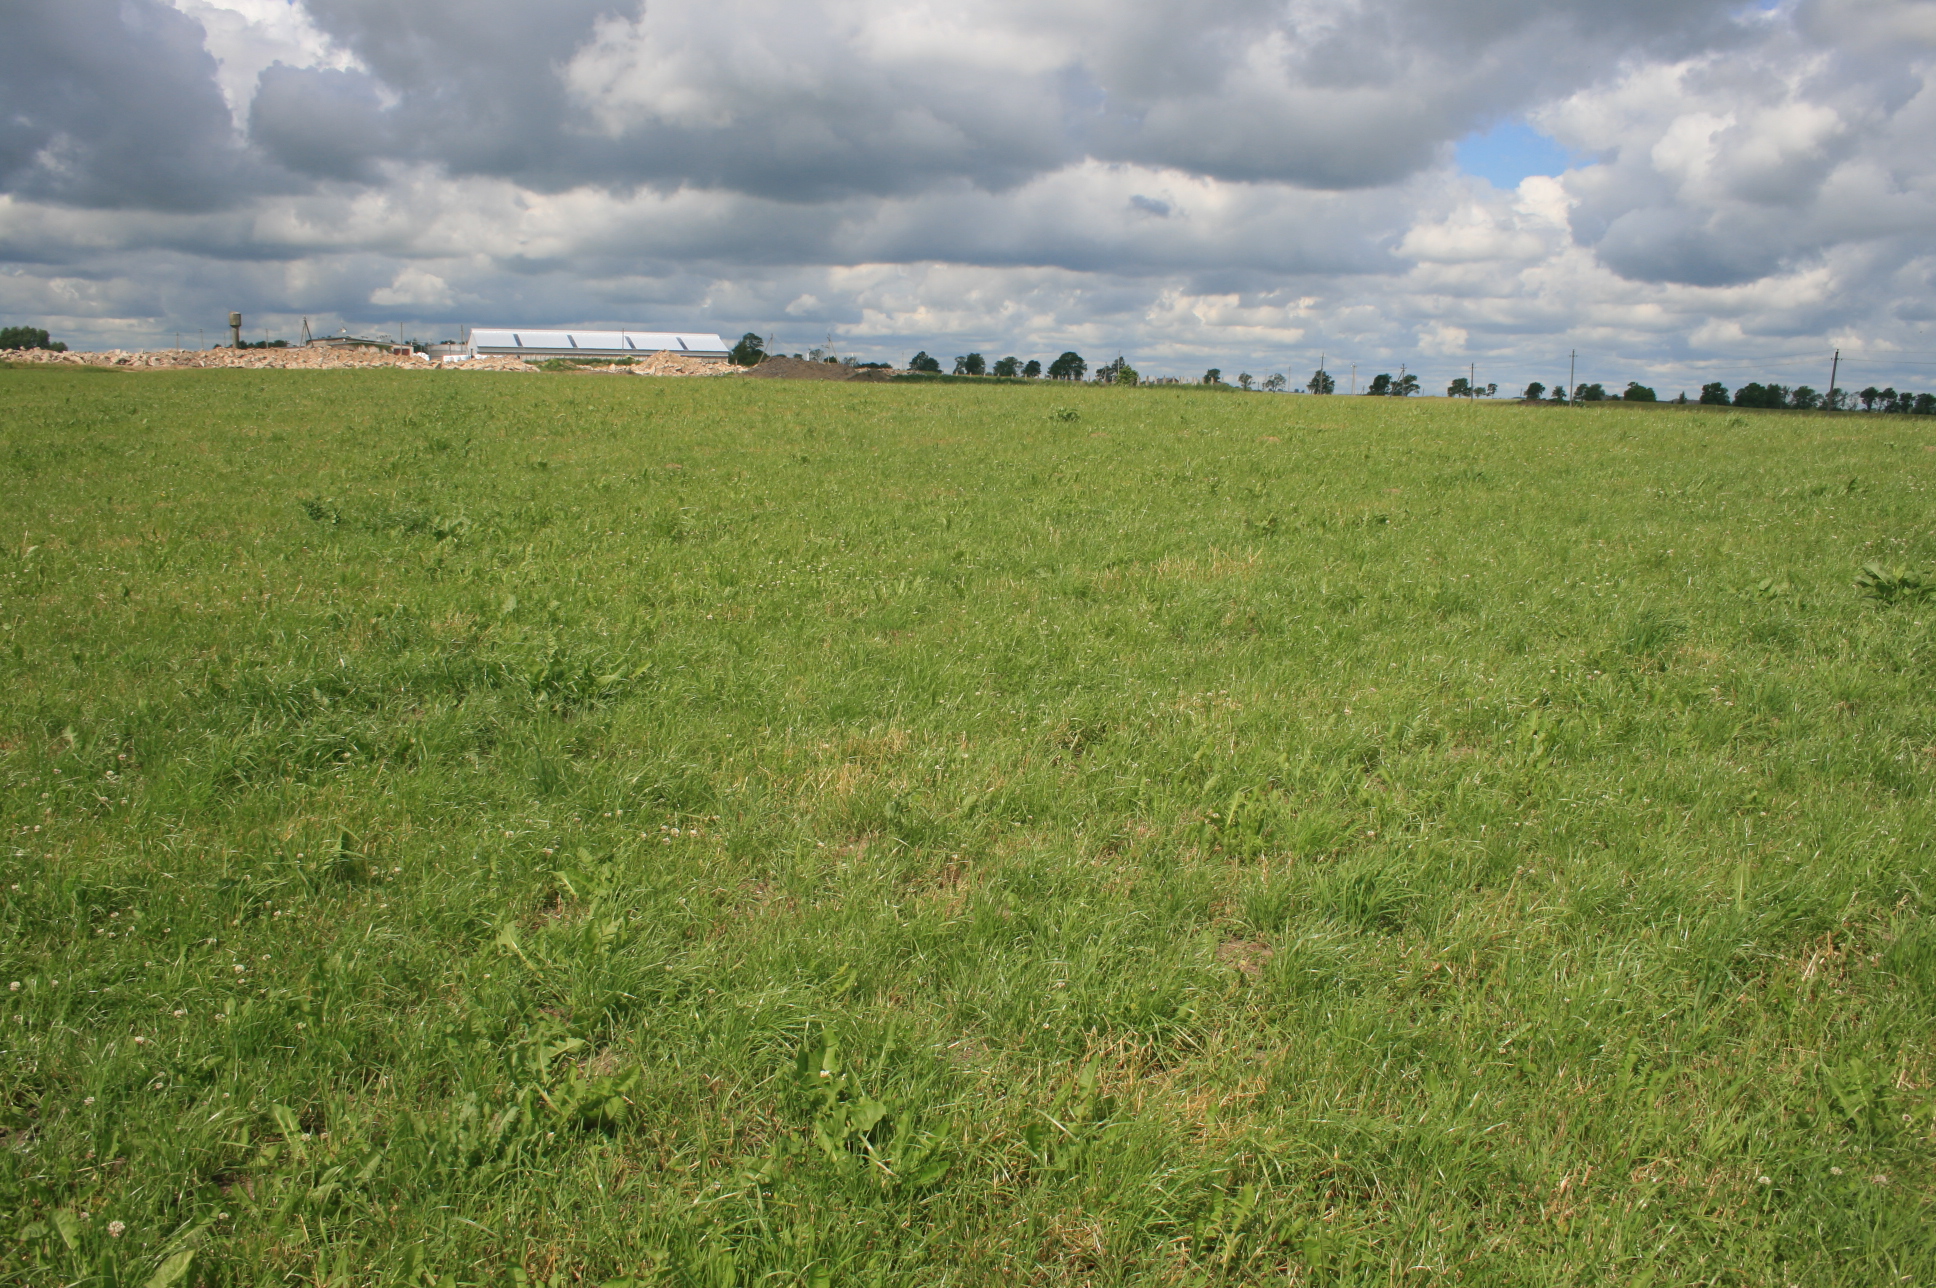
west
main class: Grassland
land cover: Grassland without tree/shrub cover
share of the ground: > 75 %
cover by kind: herbaceous plants 100 %
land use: Agriculture (excluding fallow land and kitchen gardens)
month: June
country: LT
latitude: 55.2143
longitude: 22.0786
